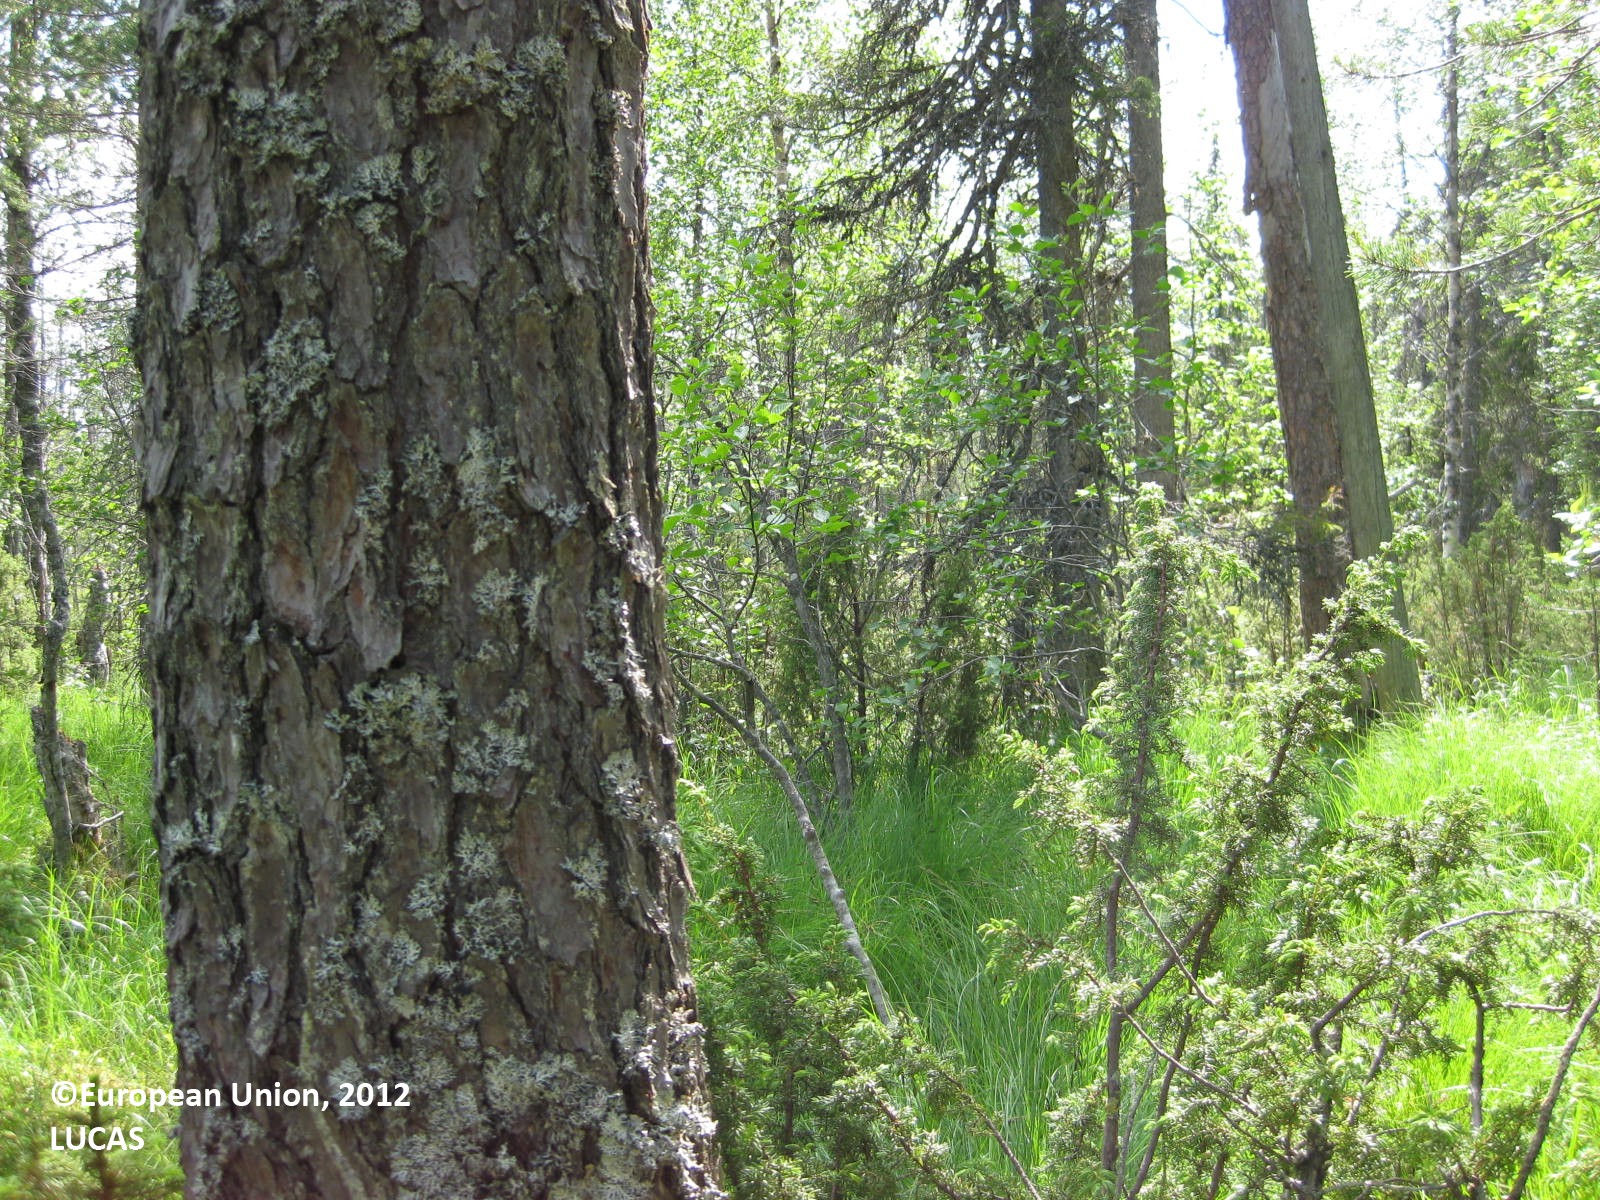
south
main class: Woodland
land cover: Pine dominated mixed woodland
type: boreal forest
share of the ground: > 75 %
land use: Semi-natural and natural areas not in use
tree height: > 5 m
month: July
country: FI
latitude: 65.5372
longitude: 29.3000
